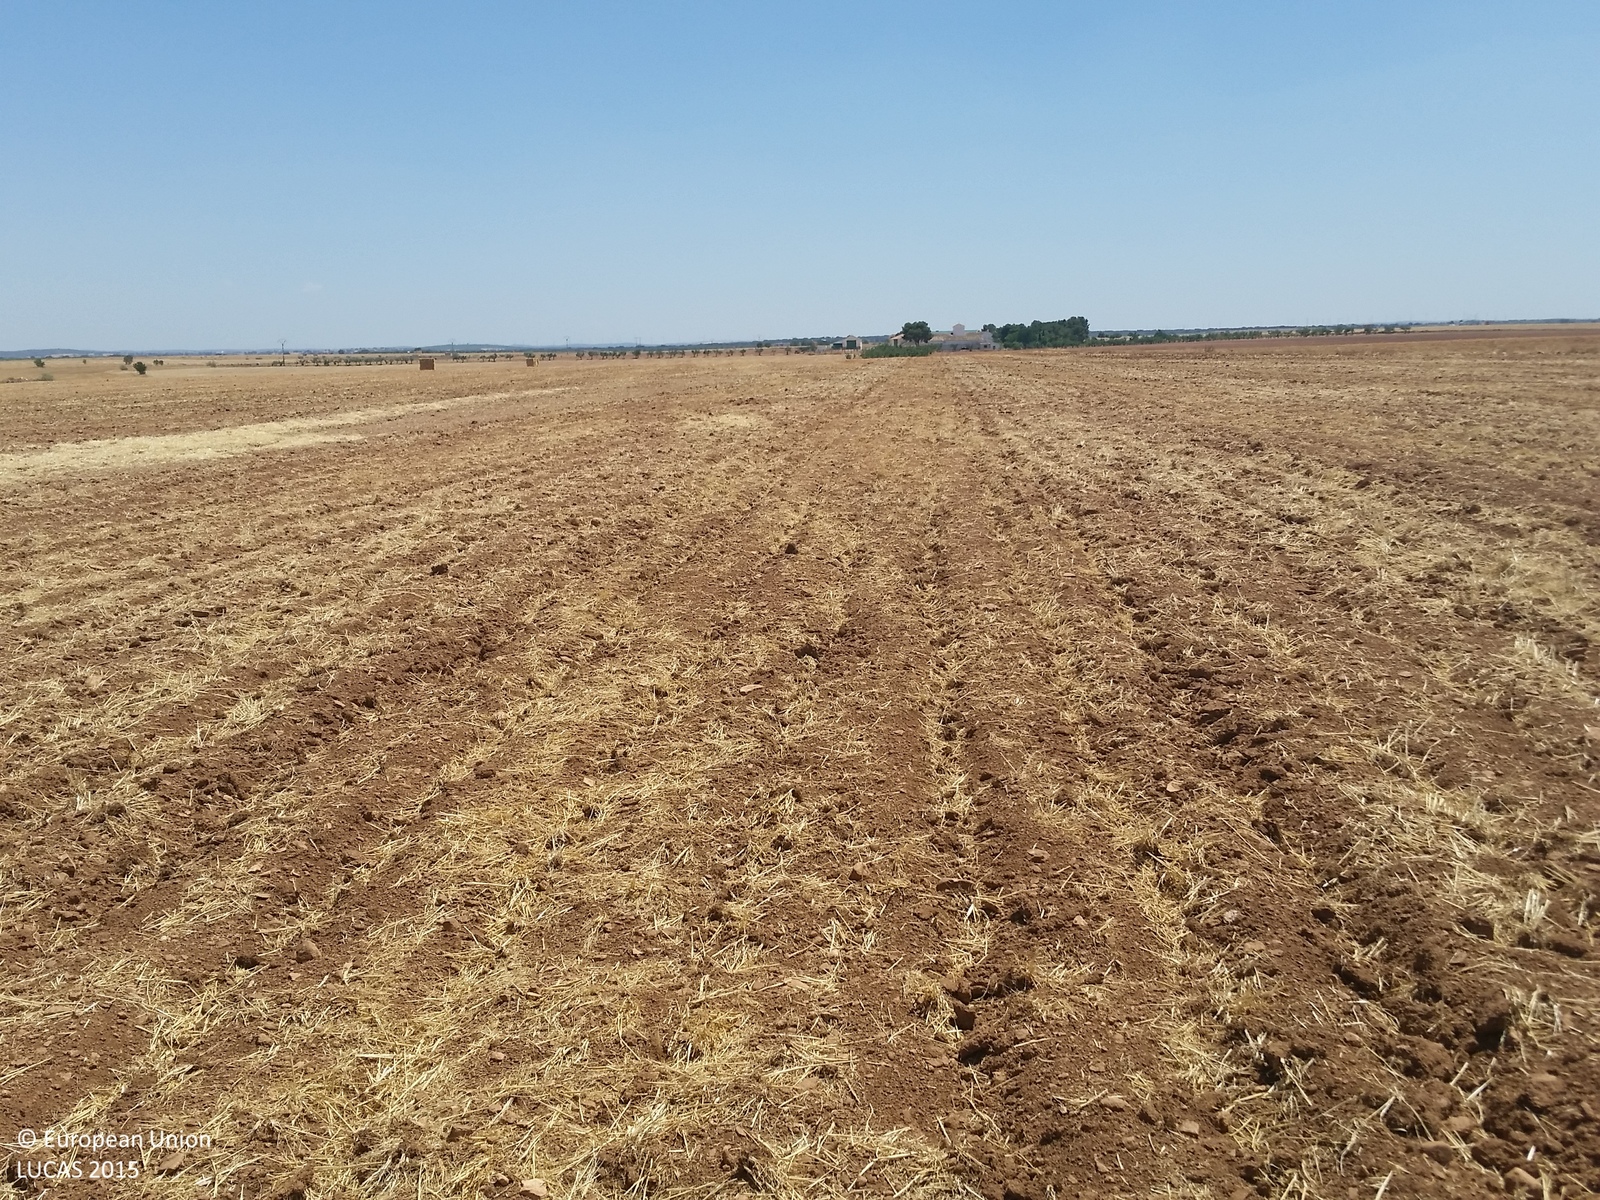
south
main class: Cropland
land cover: Barley
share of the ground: < 10 %
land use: Agriculture (excluding fallow land and kitchen gardens)
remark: Harvested field
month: July
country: ES
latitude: 39.1633
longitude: -2.5654
